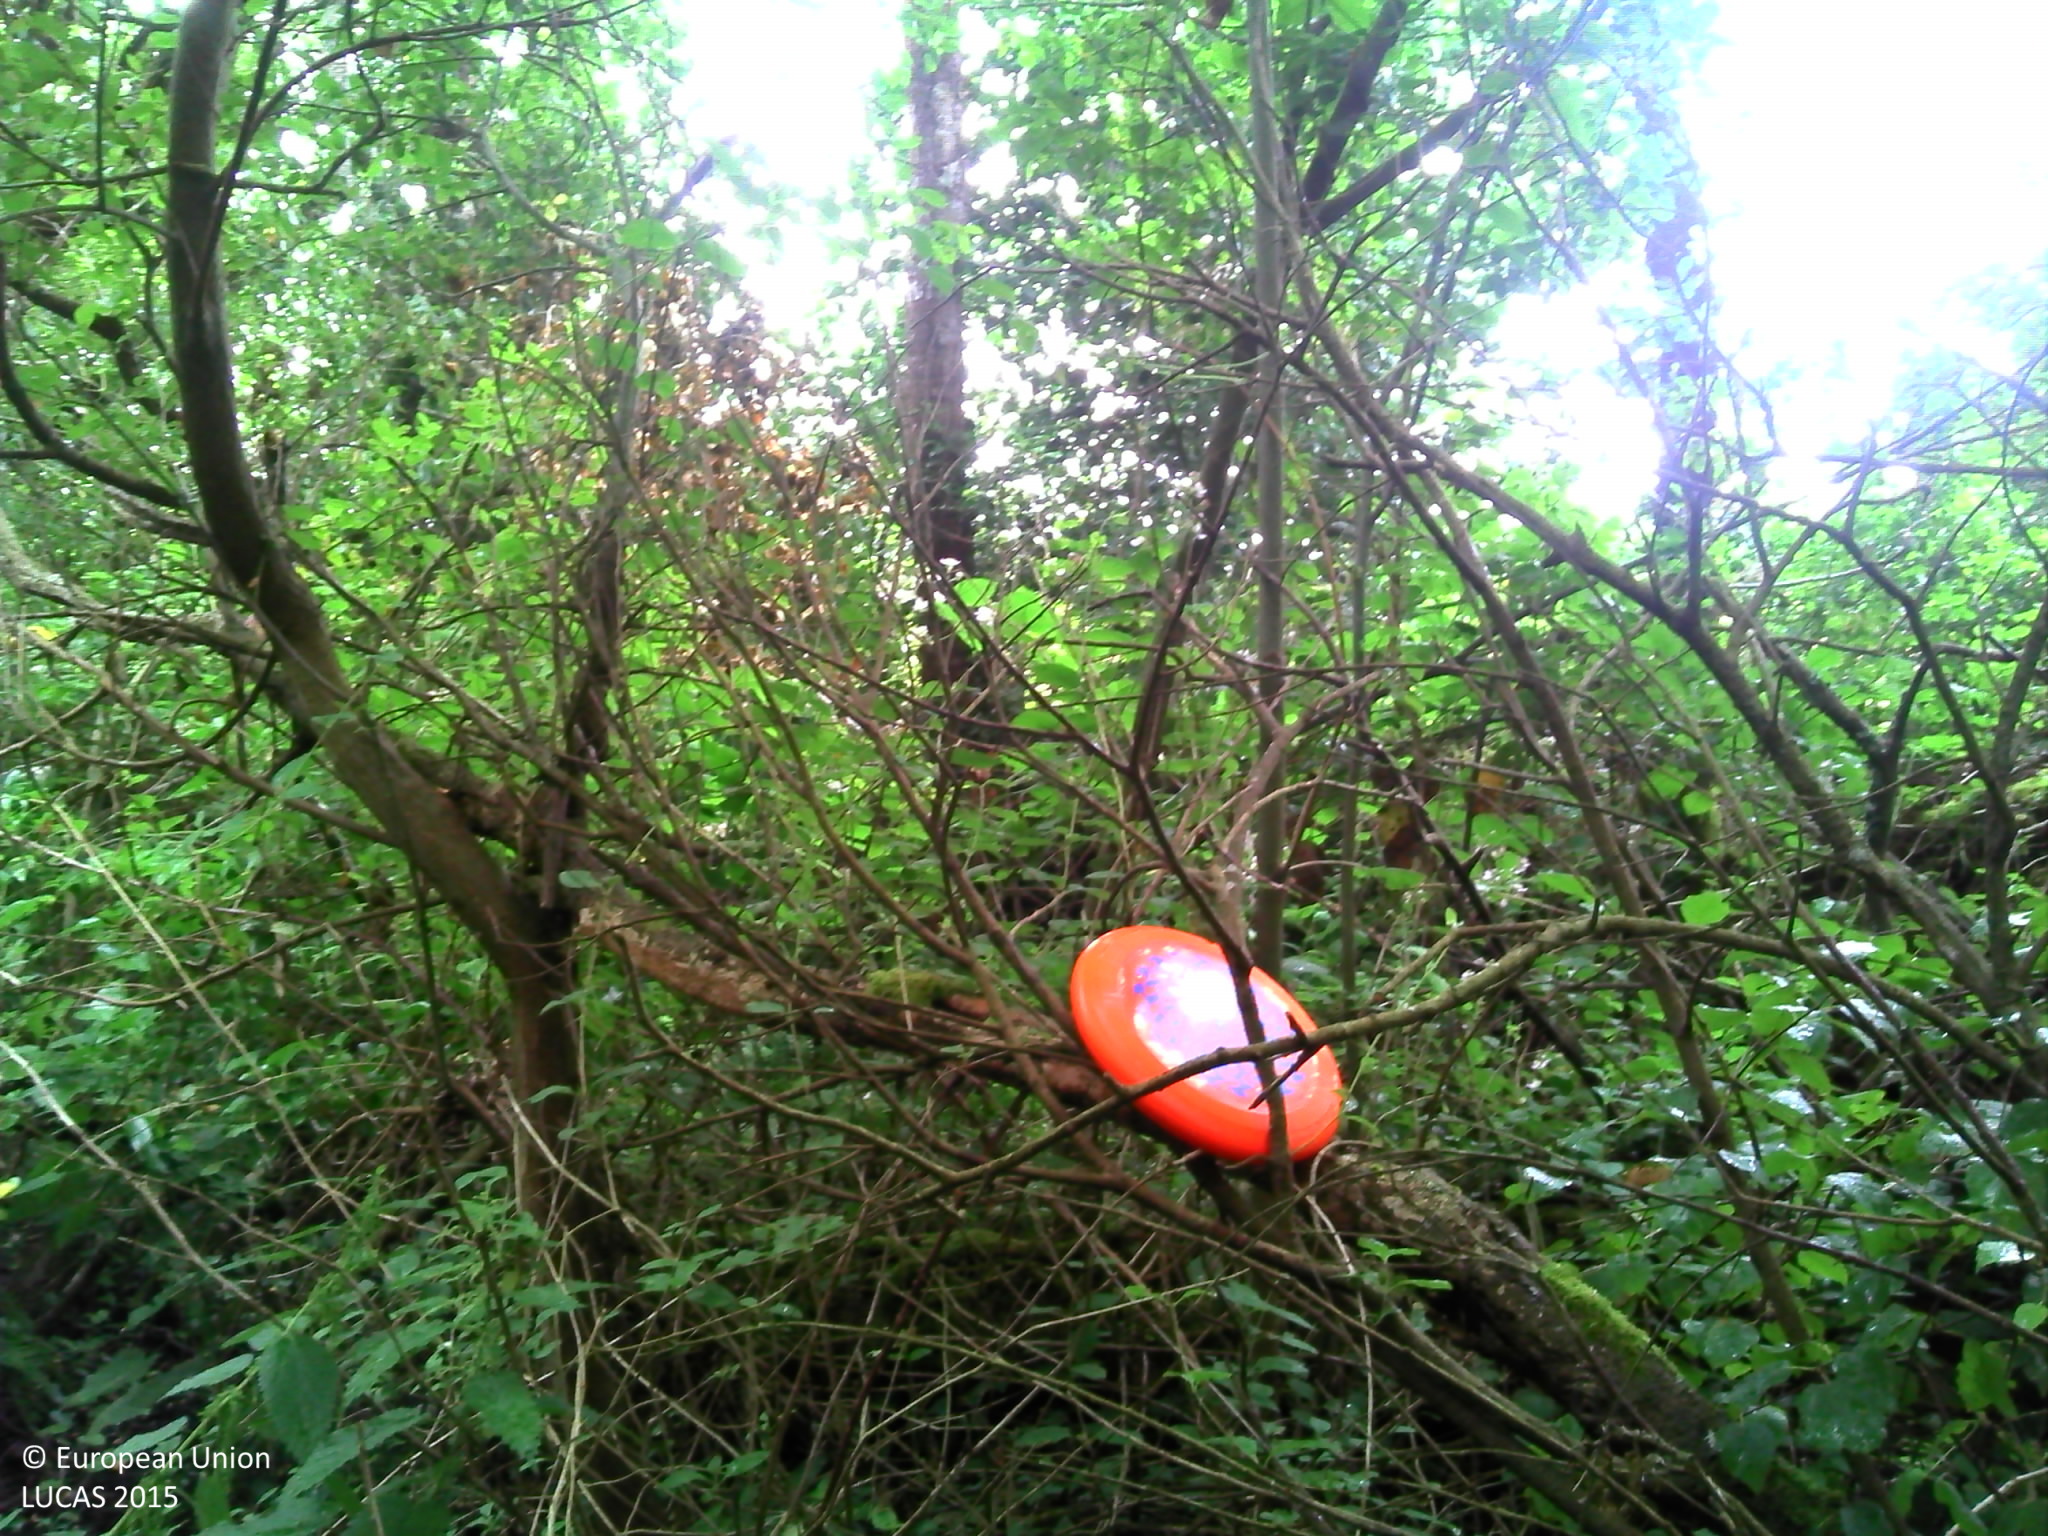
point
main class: Woodland
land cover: Broadleaved woodland
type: mesophytic deciduous forest
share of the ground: > 75 %
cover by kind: herbaceous plants 50 %, broadleaved forest trees 30 %, coniferous forest trees 10 %, unconsolidated bare surface 10 %
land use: Forestry
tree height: > 5 m
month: July
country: FR
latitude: 48.5793
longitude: -3.4571
